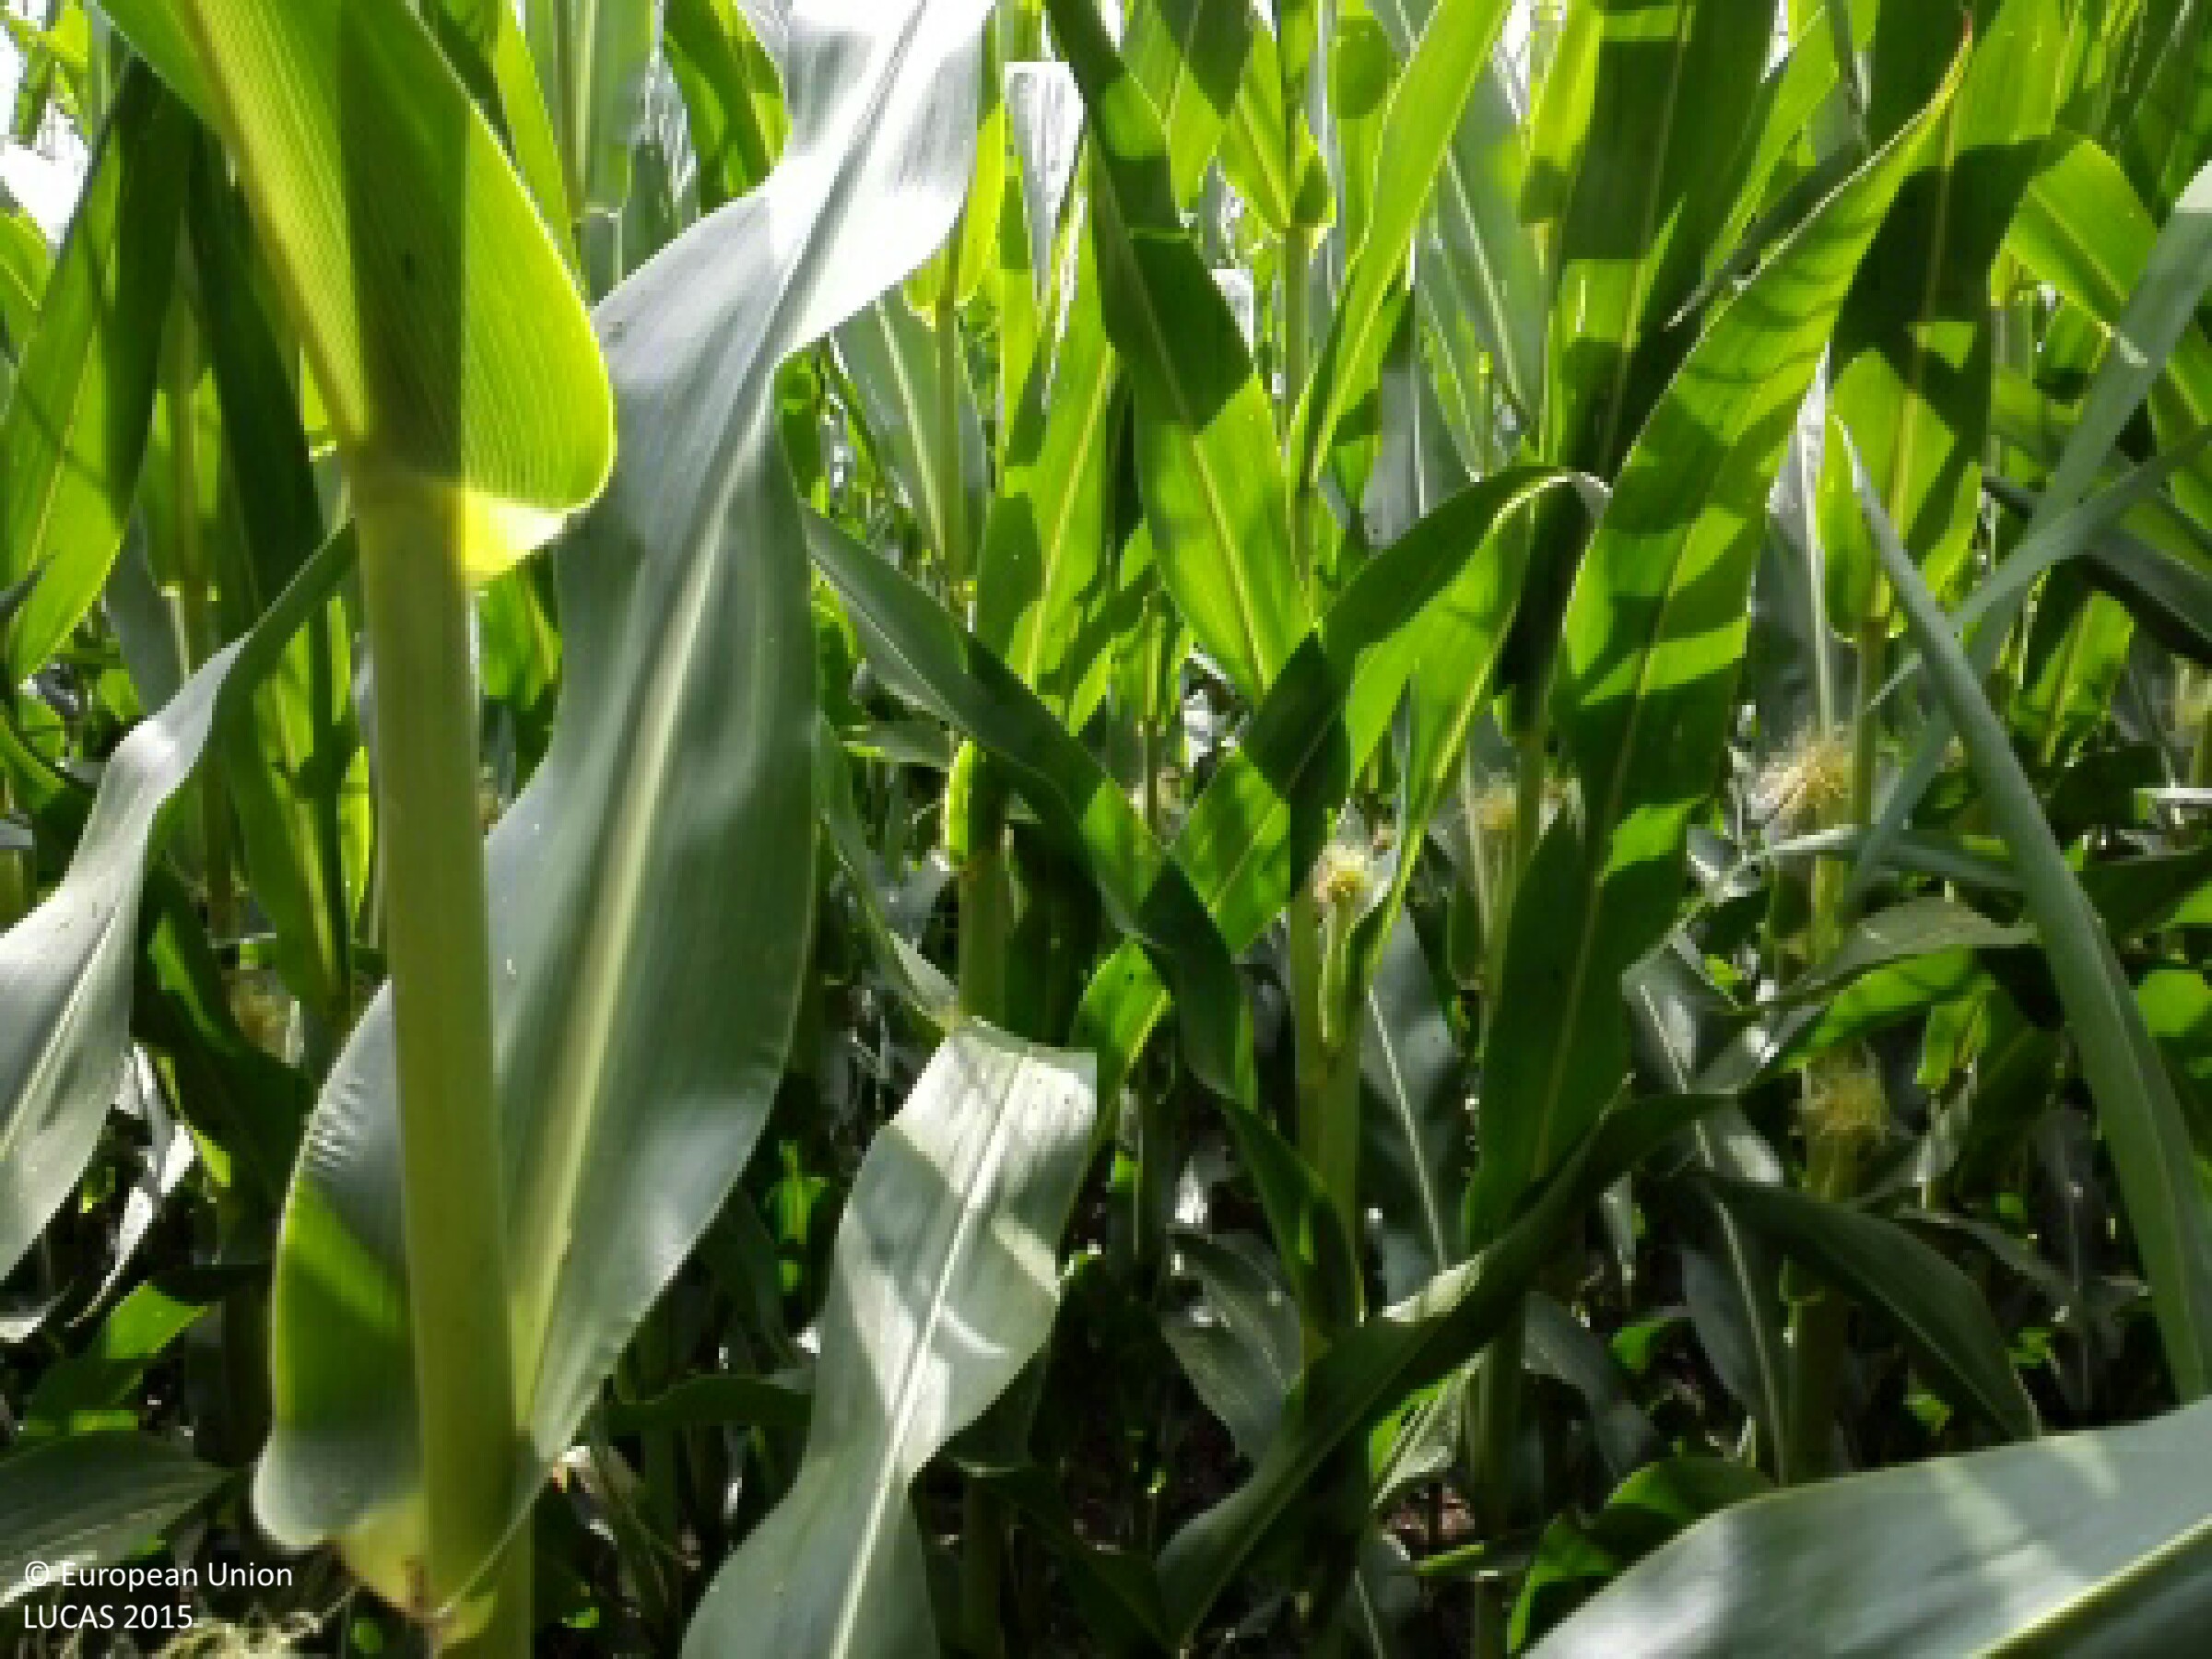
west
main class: Cropland
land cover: Maize
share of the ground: > 75 %
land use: Agriculture (excluding fallow land and kitchen gardens)
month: July
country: HU
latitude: 47.5446
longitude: 21.3479
